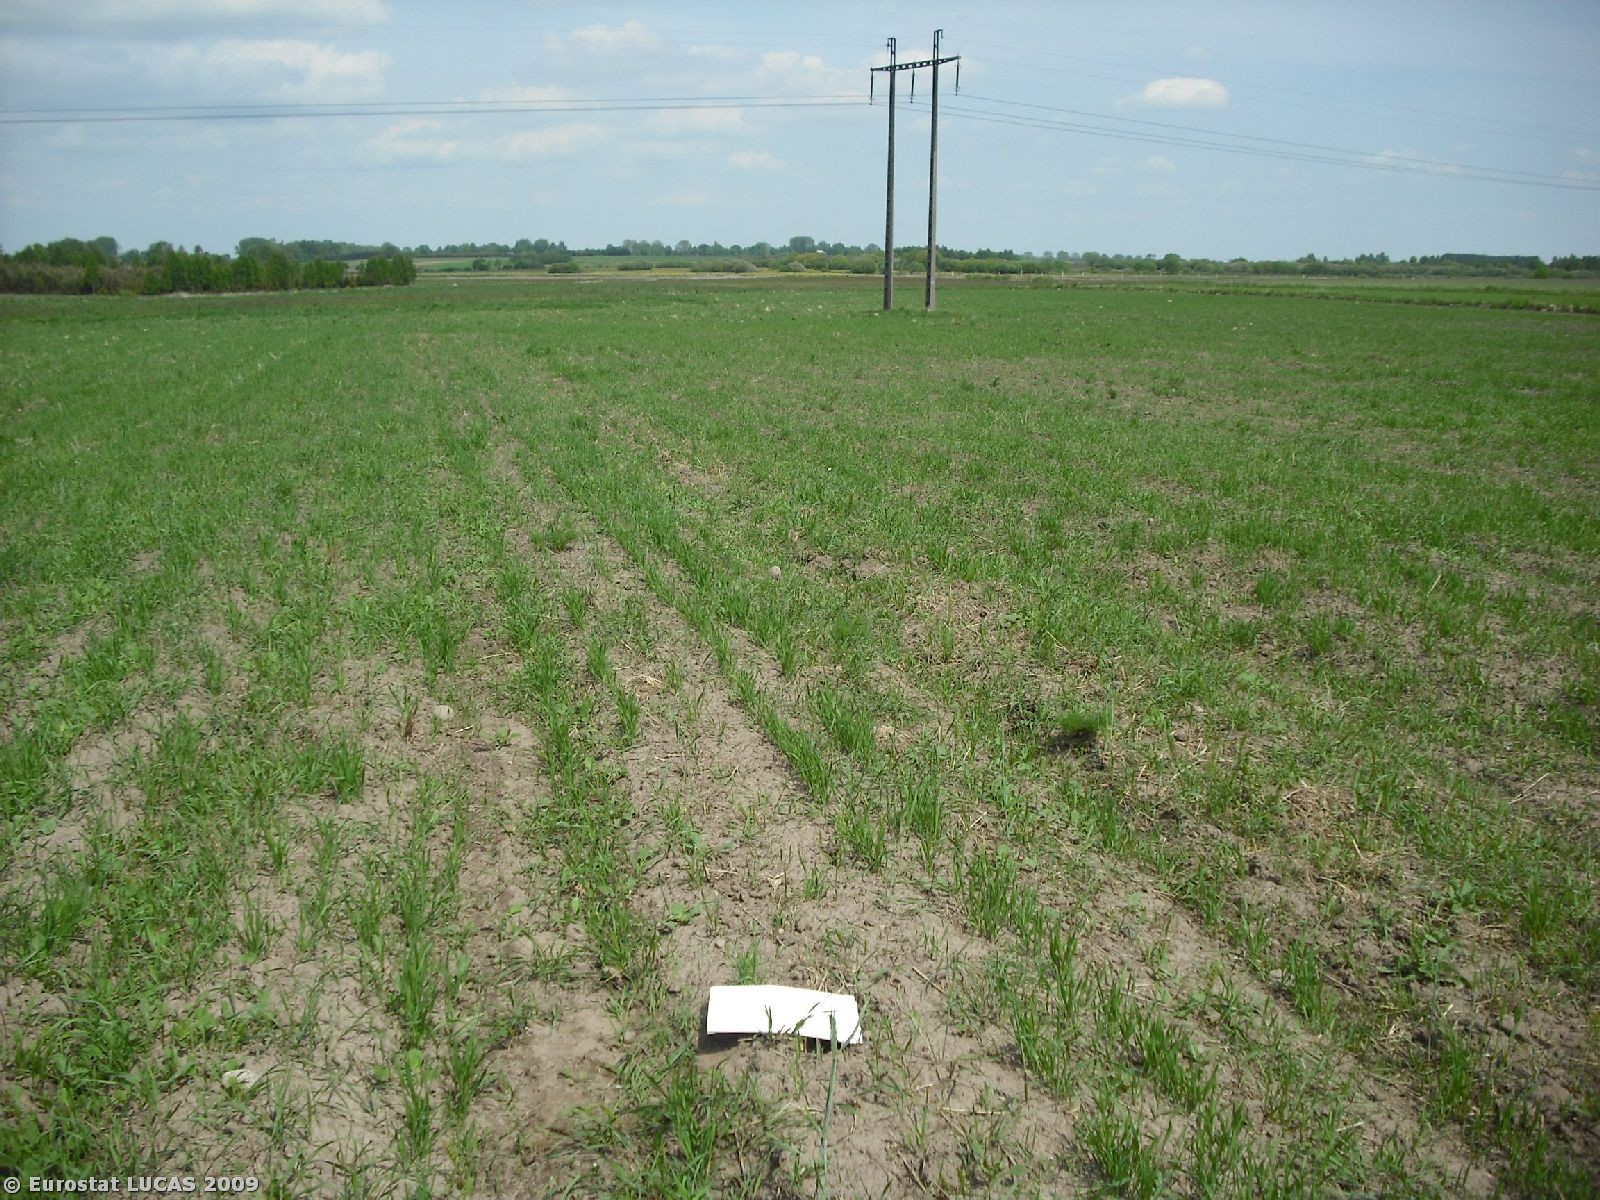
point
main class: Cropland
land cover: Oats
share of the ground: 50 - 75 %
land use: Agriculture (excluding fallow land and kitchen gardens)
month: May
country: PL
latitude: 52.7813
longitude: 23.2294
